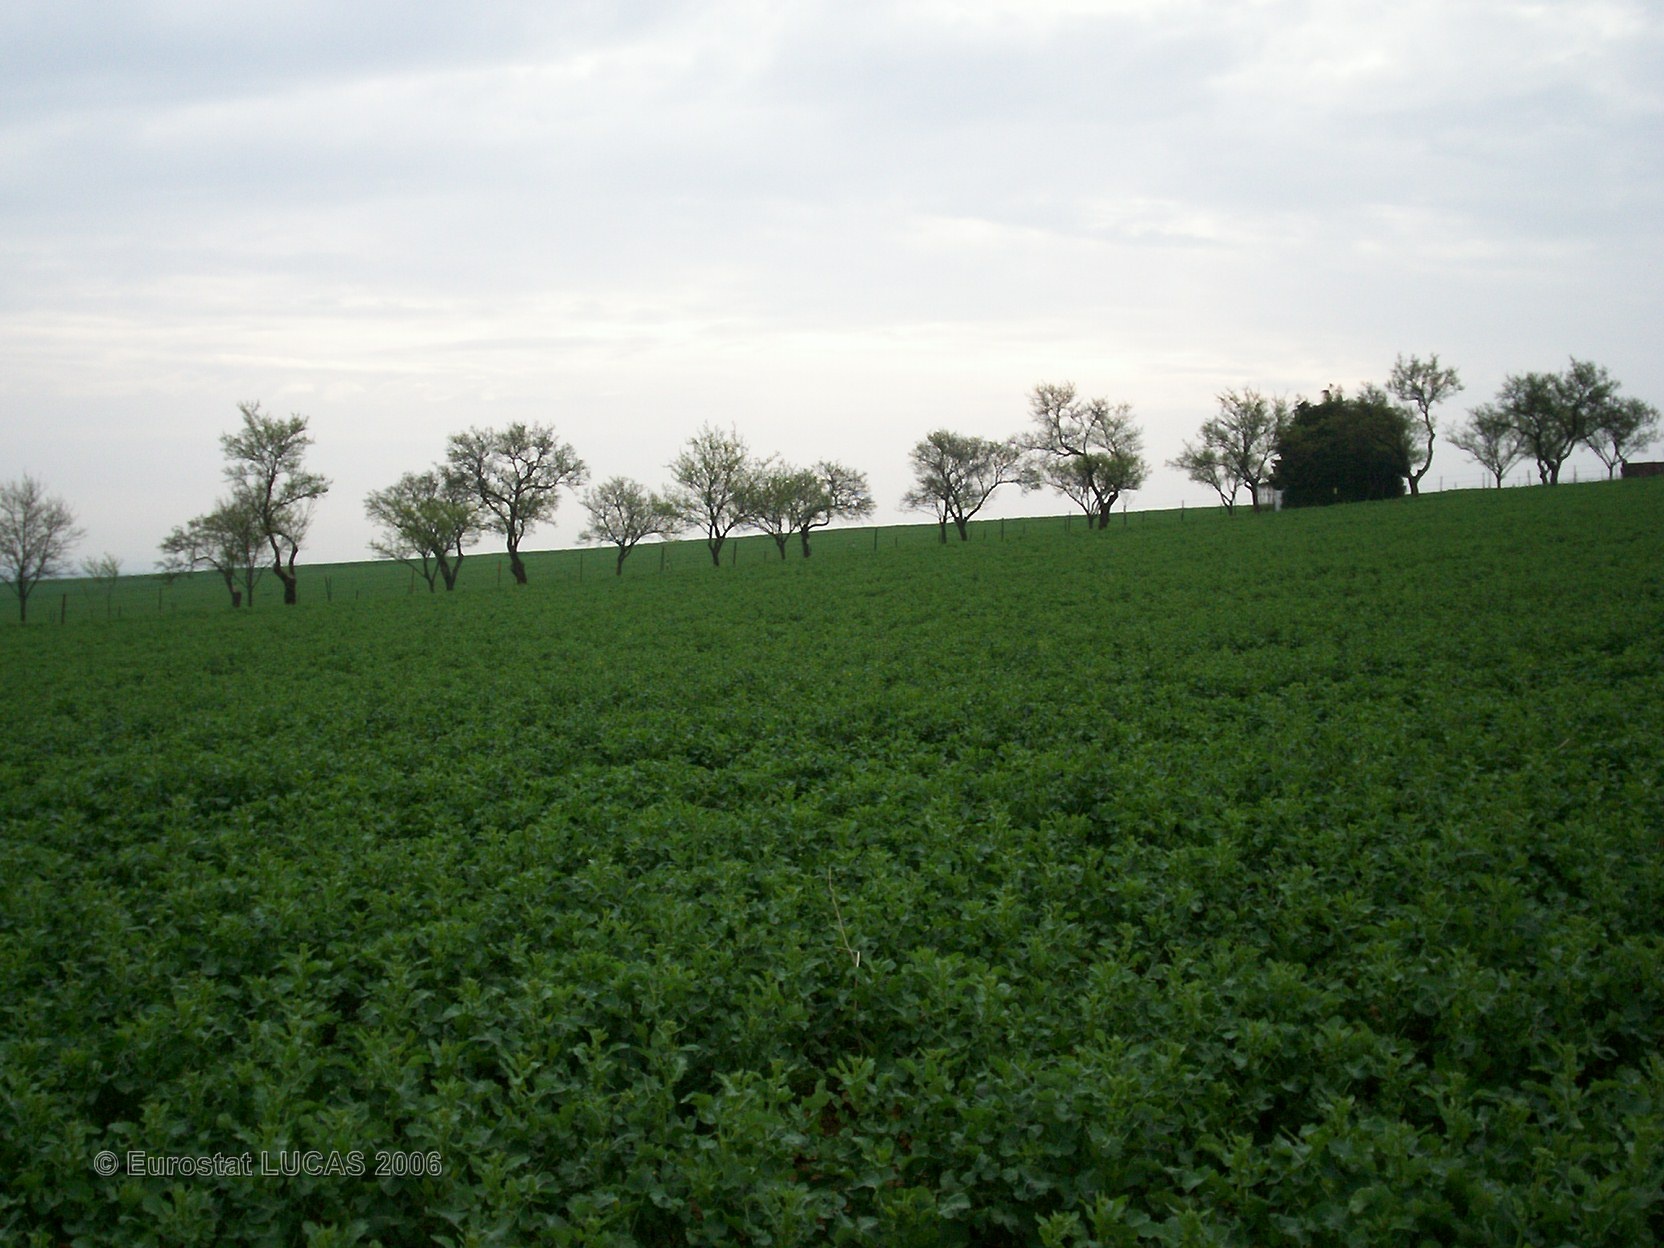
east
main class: Cropland
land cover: Rape and turnip rape
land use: Agriculture (excluding fallow land and kitchen gardens)
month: April
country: FR
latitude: 48.1882
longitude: 6.0322
